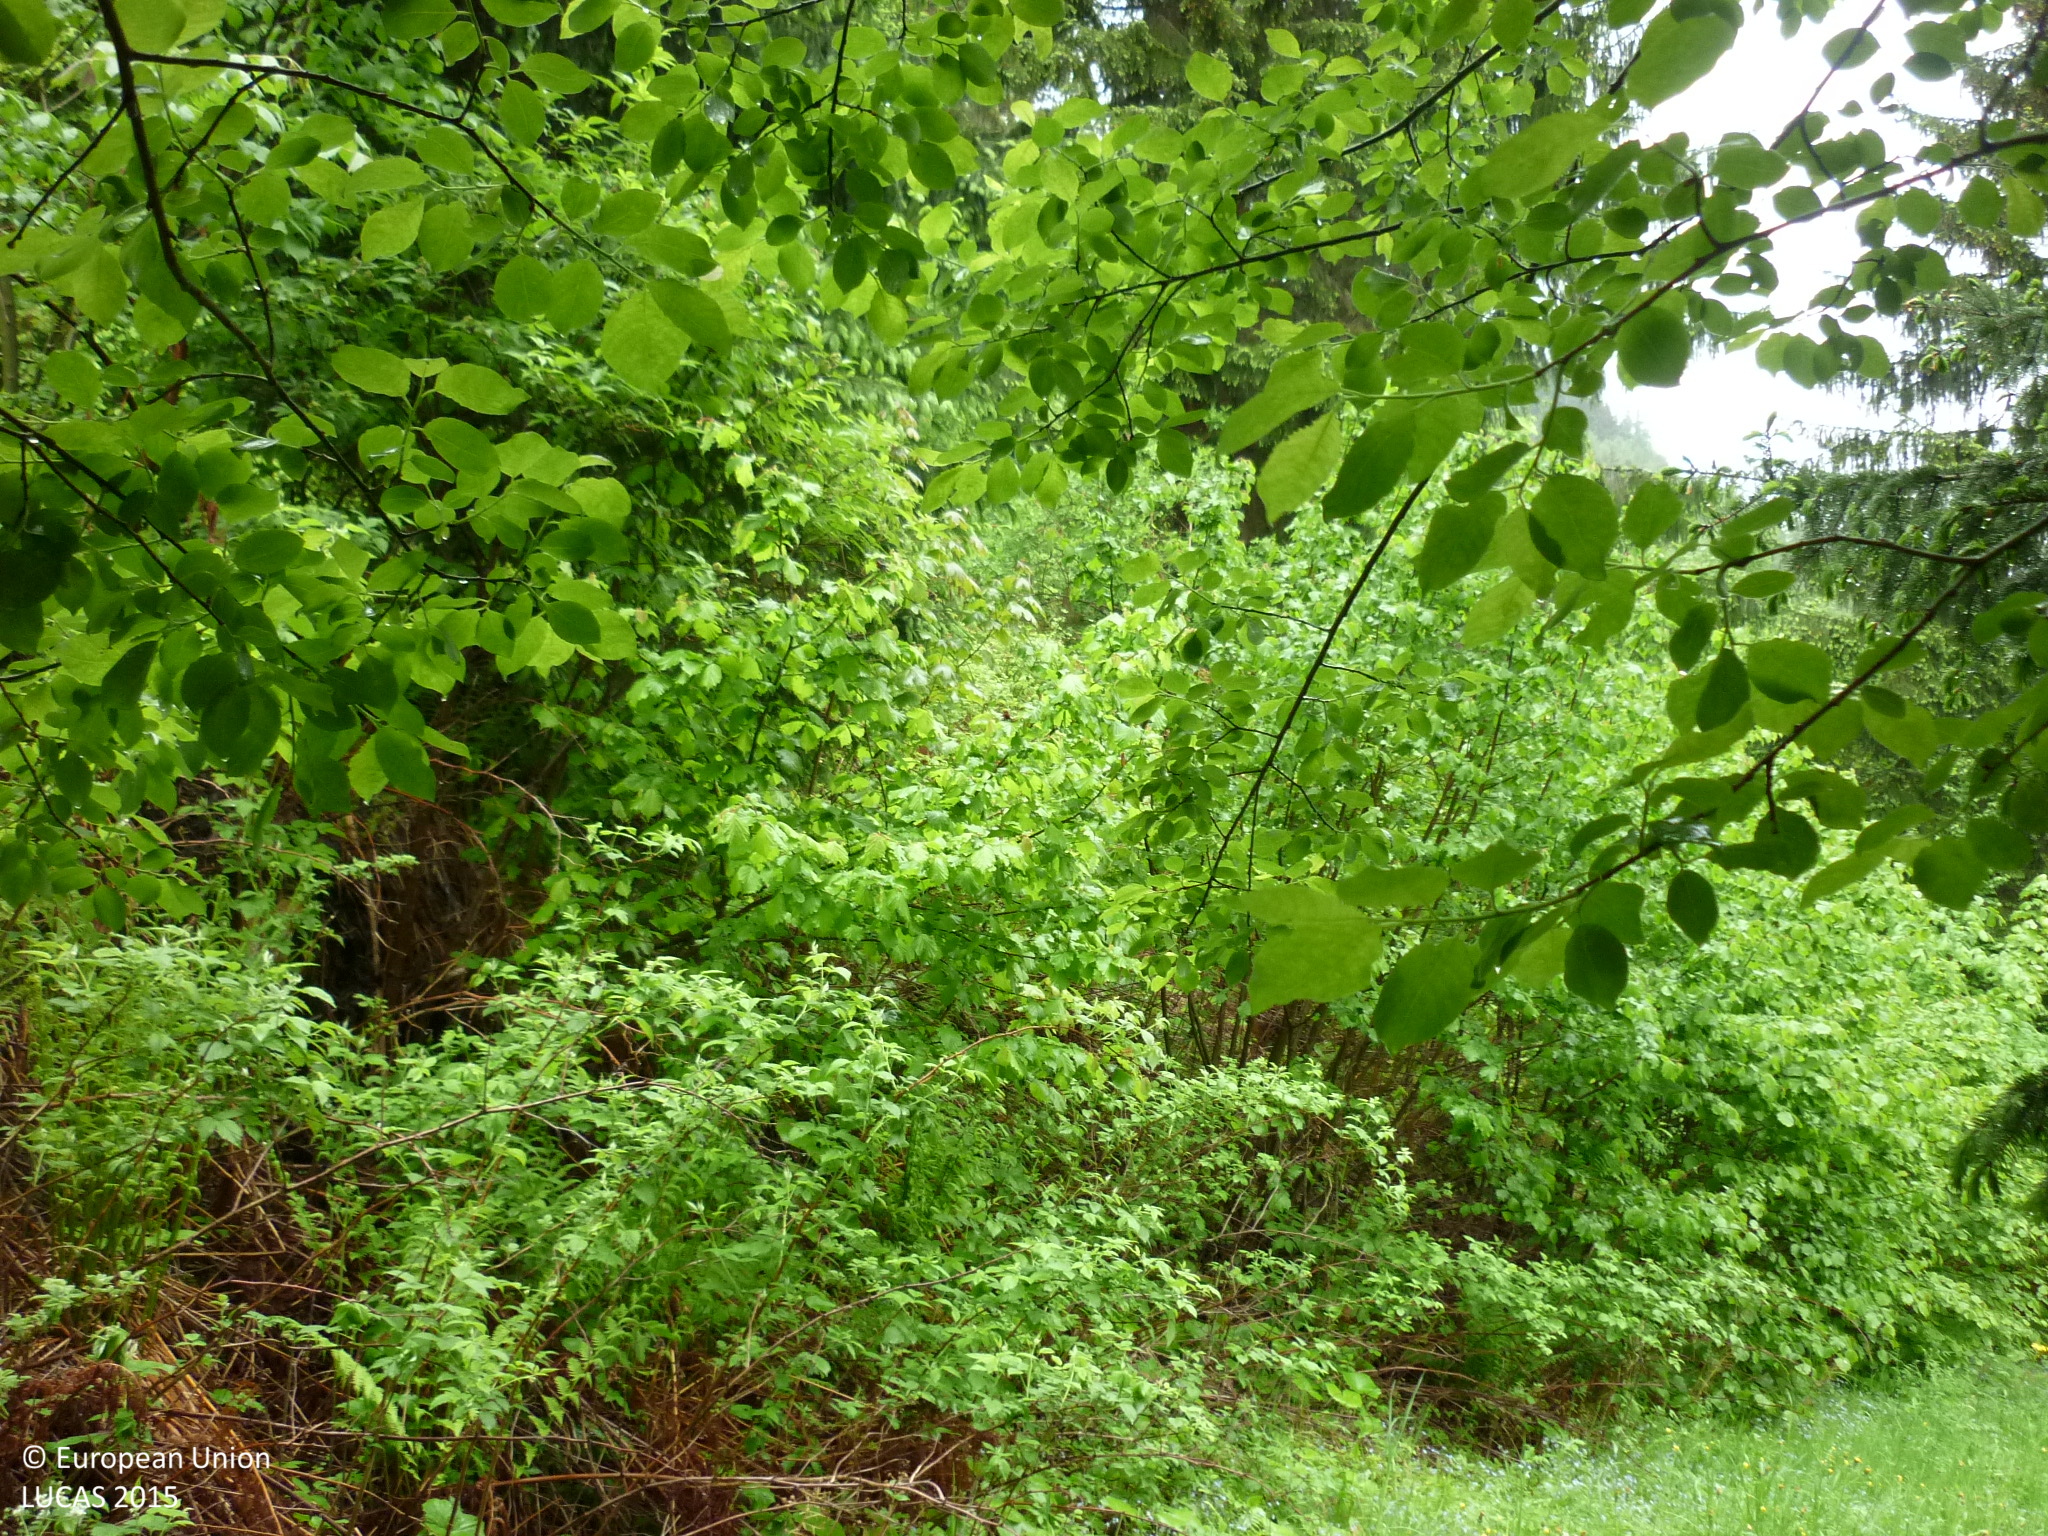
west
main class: Woodland
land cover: Spruce dominated mixed woodland
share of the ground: > 75 %
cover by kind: coniferous forest trees 45 %, broadleaved forest trees 30 %, herbaceous plants 25 %
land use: Forestry
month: May
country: AT
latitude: 47.1032
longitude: 14.0696
